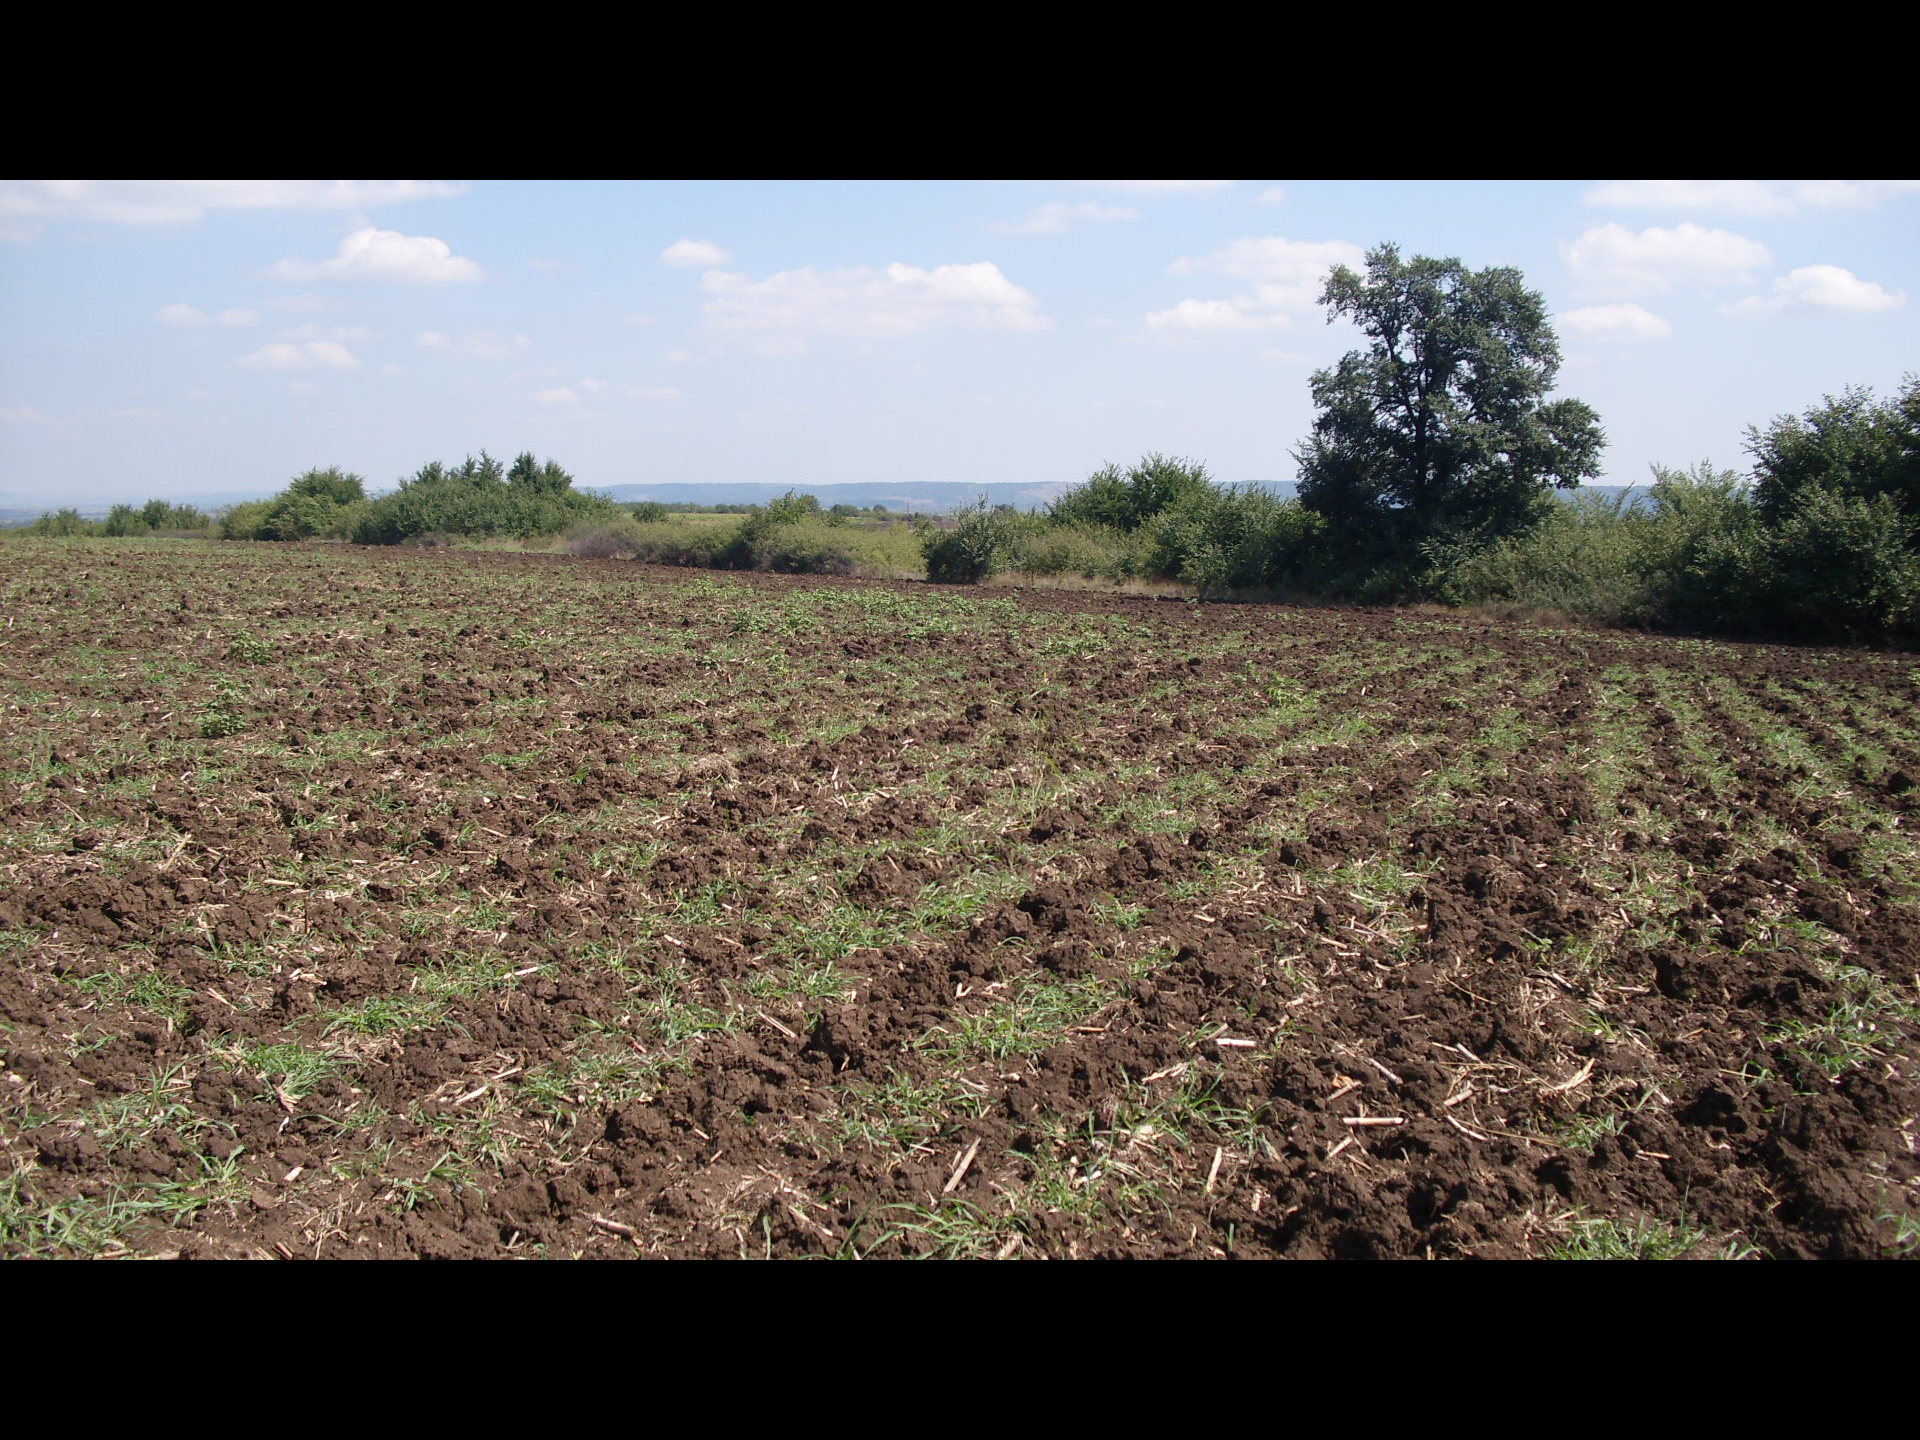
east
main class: Cropland
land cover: Maize
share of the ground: < 10 %
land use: Agriculture (excluding fallow land and kitchen gardens)
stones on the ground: < 10 %
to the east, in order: Maize; Shrubland with sparse tree cover; Paved roads, cycling and walking lanes; Shrubland with sparse tree cover; Grass margins; Maize
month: August
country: BG
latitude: 43.6748
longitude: 23.0002
